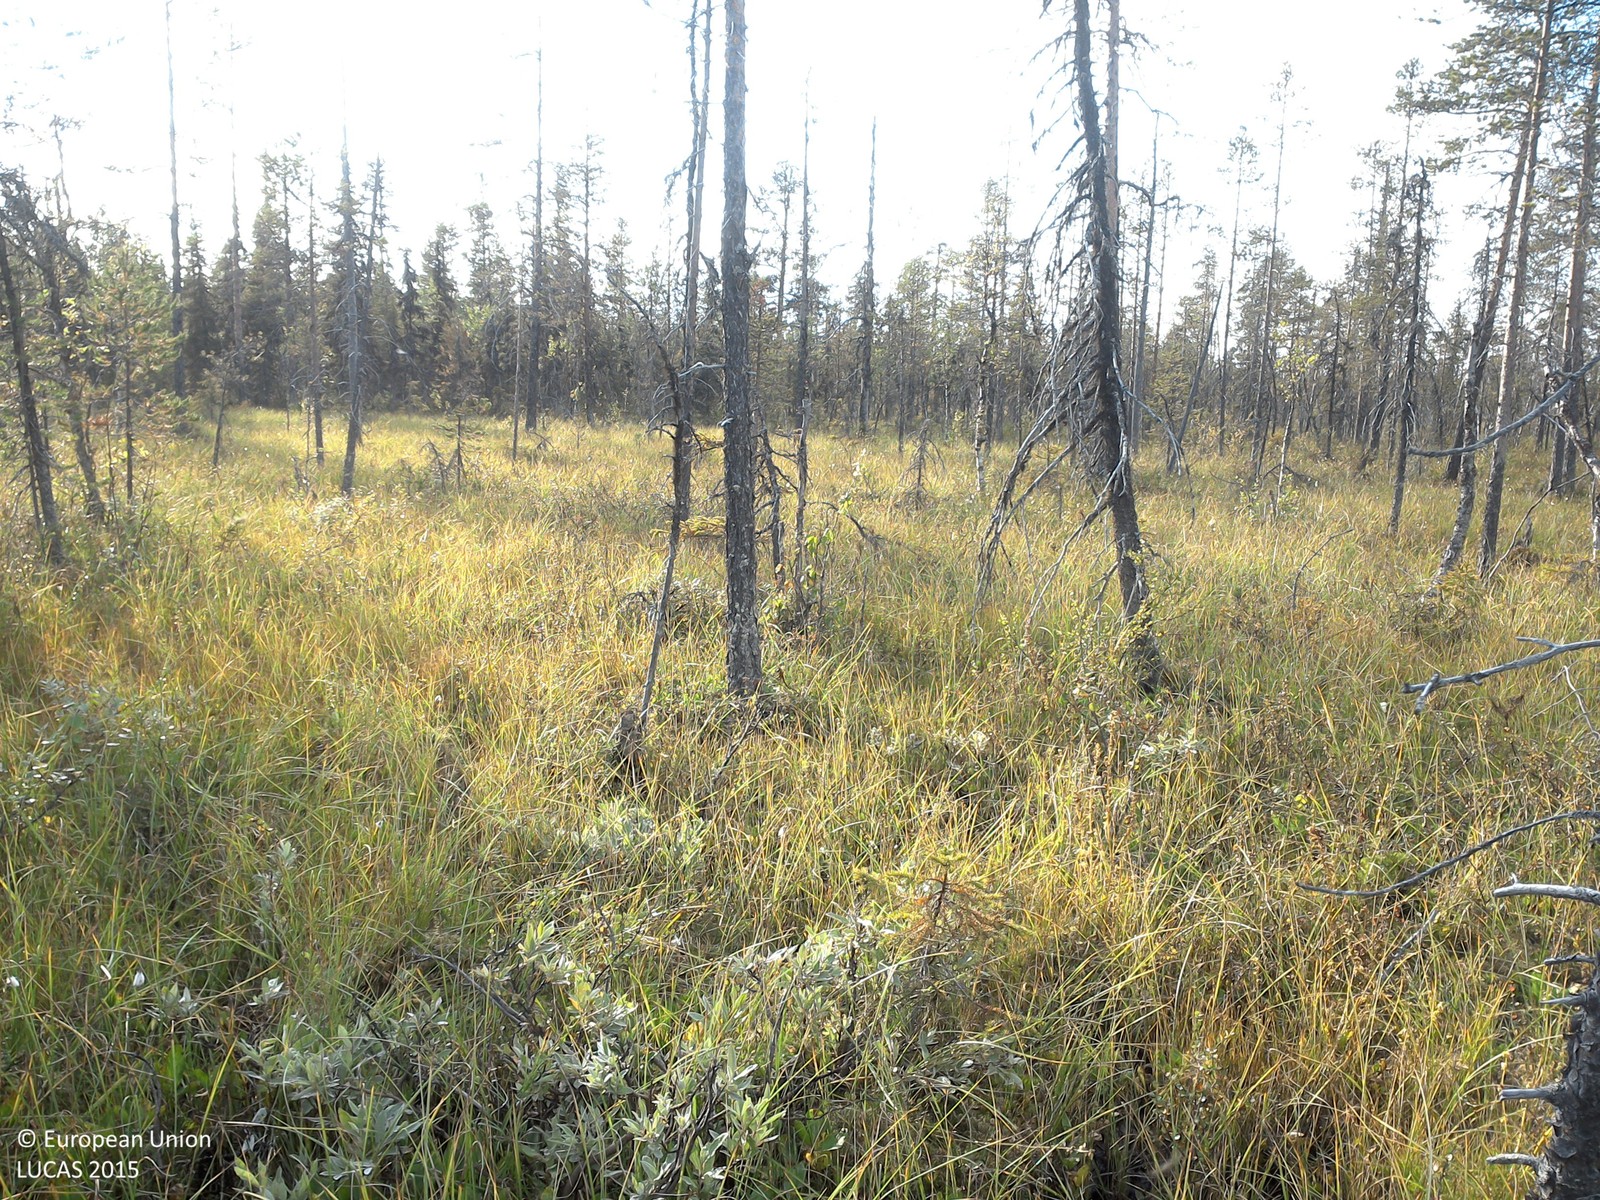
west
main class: Woodland
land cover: Other mixed woodland
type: mire and swamp forests
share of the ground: 10 - 25 %
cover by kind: herbaceous plants 55 %, lichens and mosses 20 %, coniferous forest trees 10 %, shrubs 10 %, broadleaved forest trees 5 %
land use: Semi-natural and natural areas not in use
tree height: > 5 m
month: August
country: SE
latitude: 67.2615
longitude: 21.9890
